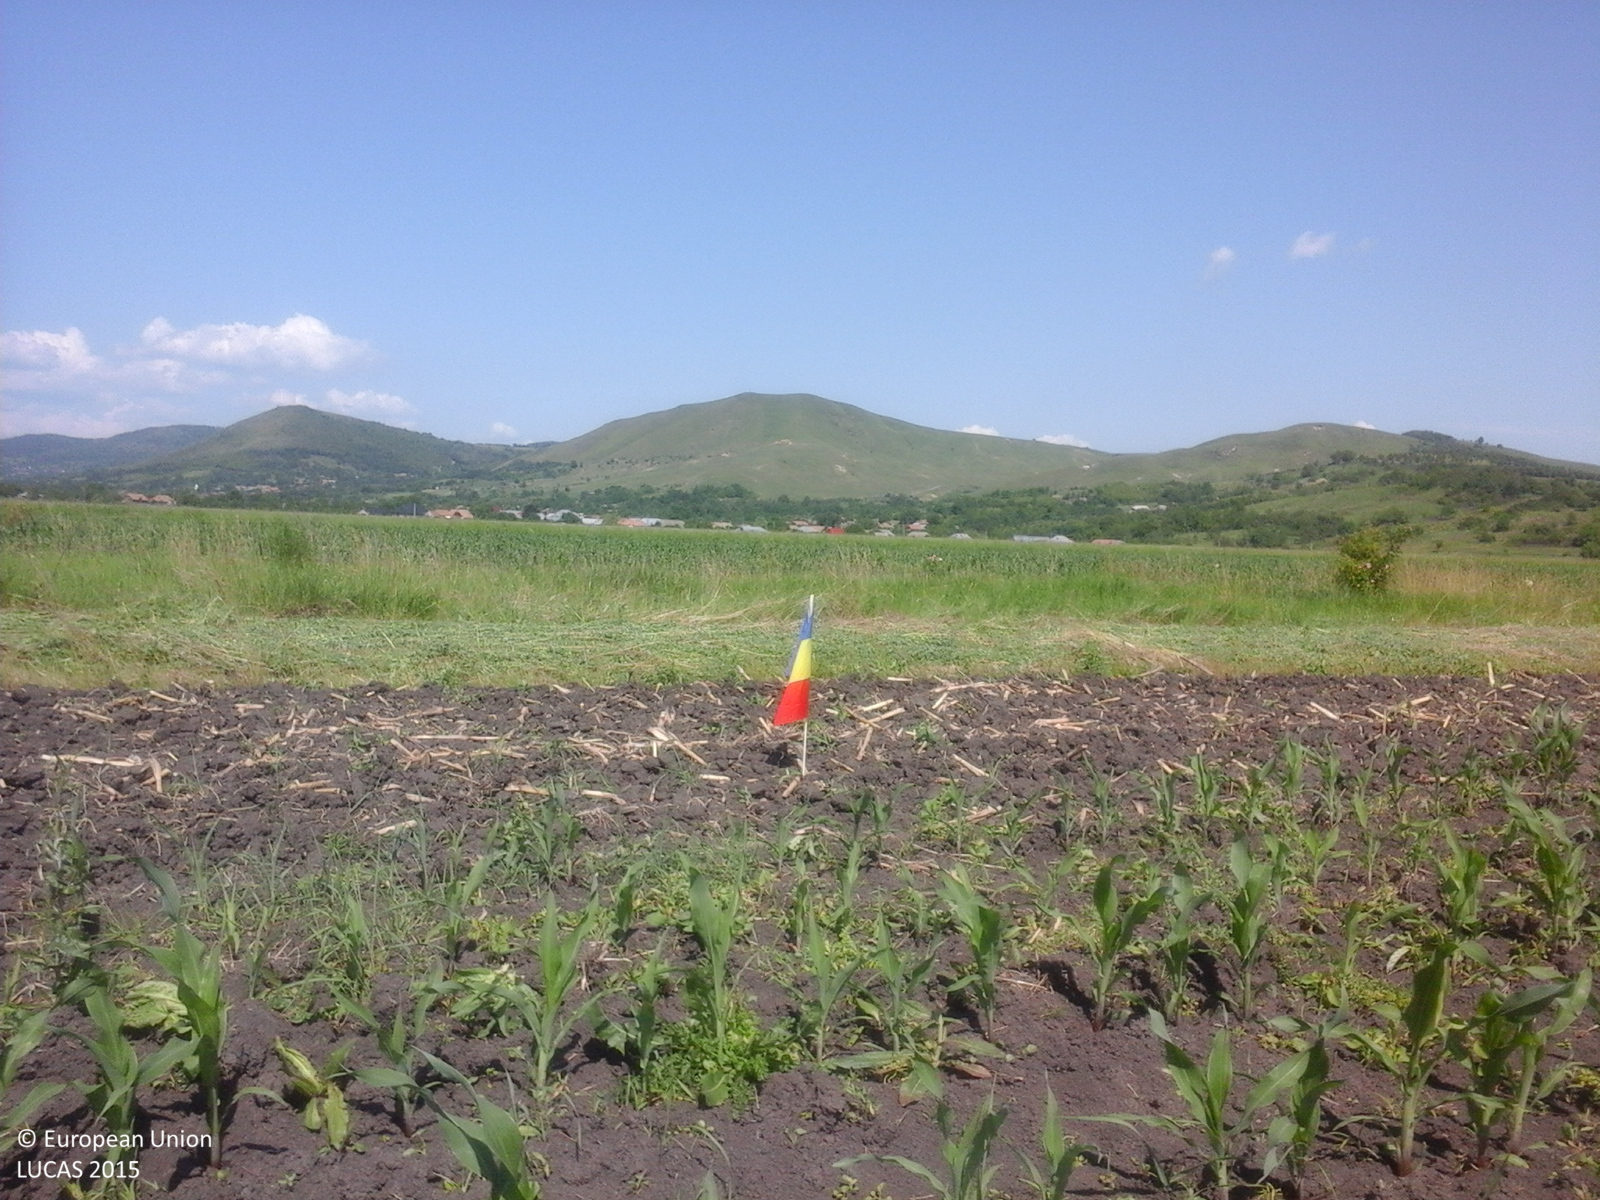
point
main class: Cropland
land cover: Maize
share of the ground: 10 - 25 %
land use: Agriculture (excluding fallow land and kitchen gardens)
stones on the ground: < 10 %
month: June
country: RO
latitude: 46.2786
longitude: 26.6839
